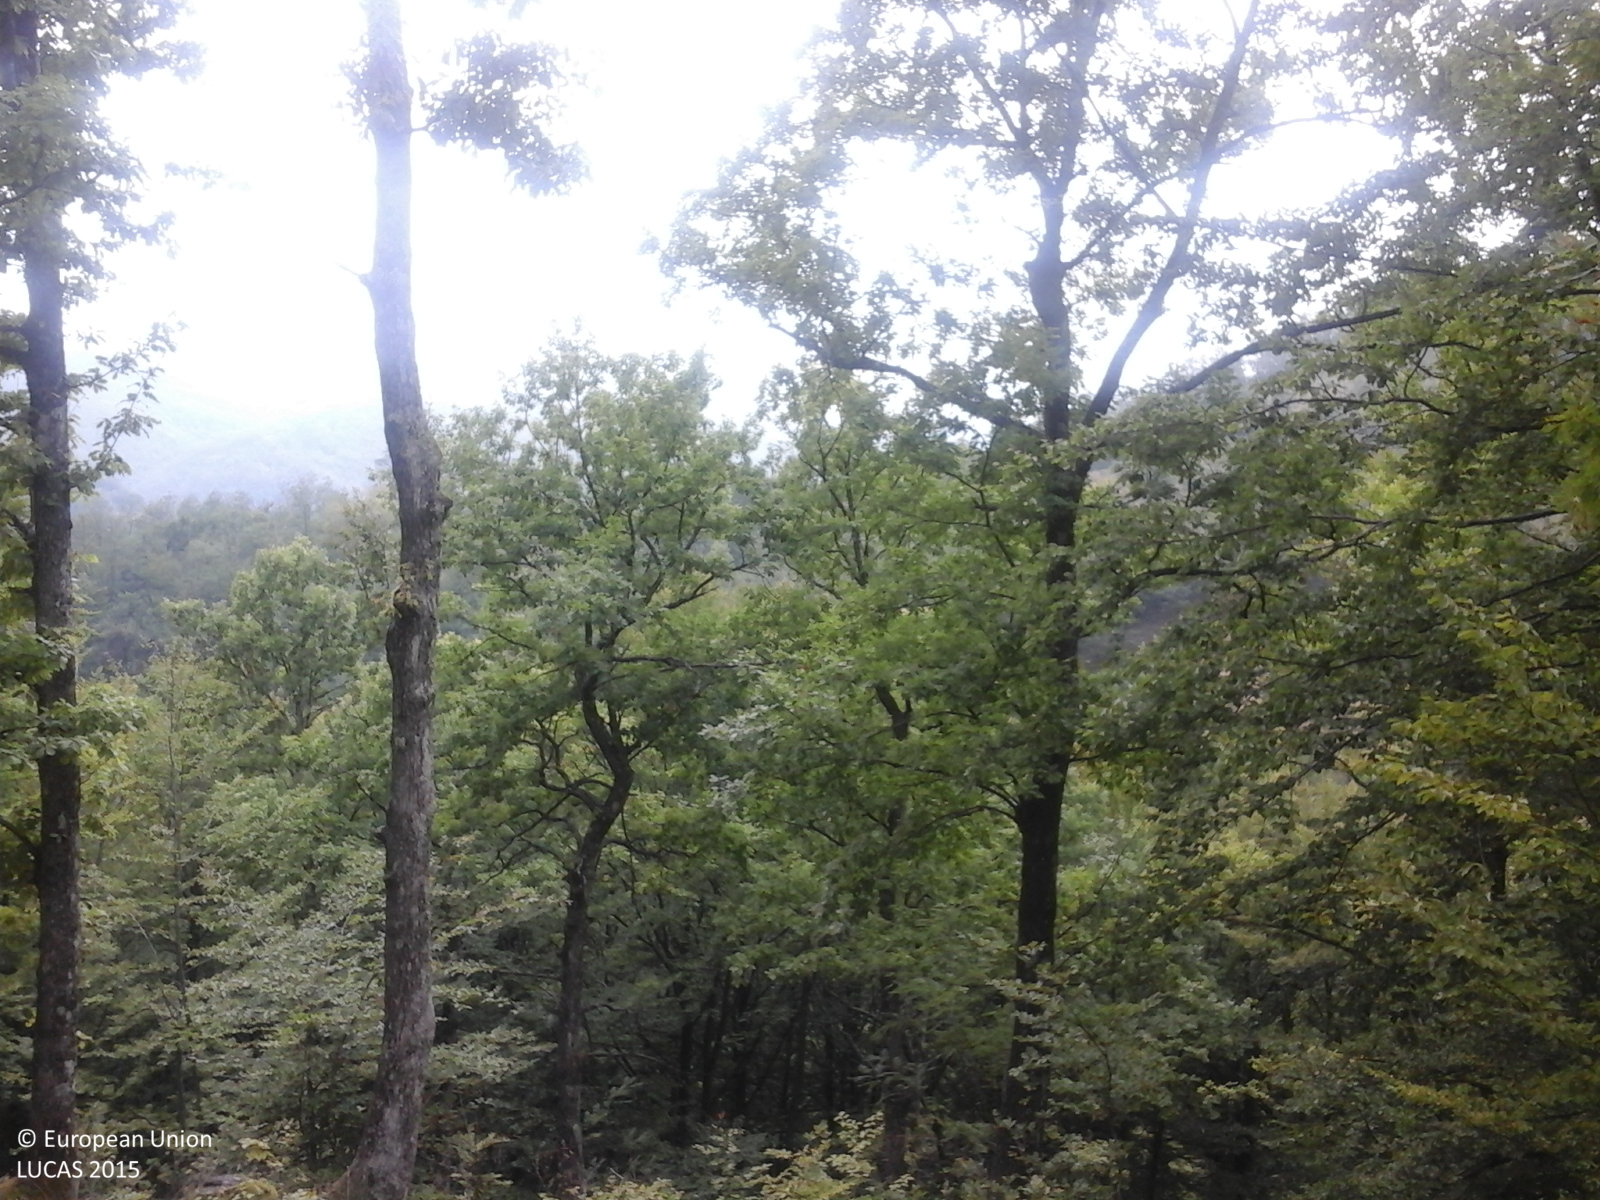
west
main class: Woodland
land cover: Broadleaved woodland
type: beech forest
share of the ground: > 75 %
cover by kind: broadleaved forest trees 100 %
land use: Forestry
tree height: > 5 m
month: September
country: RO
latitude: 45.0459
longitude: 22.8320
